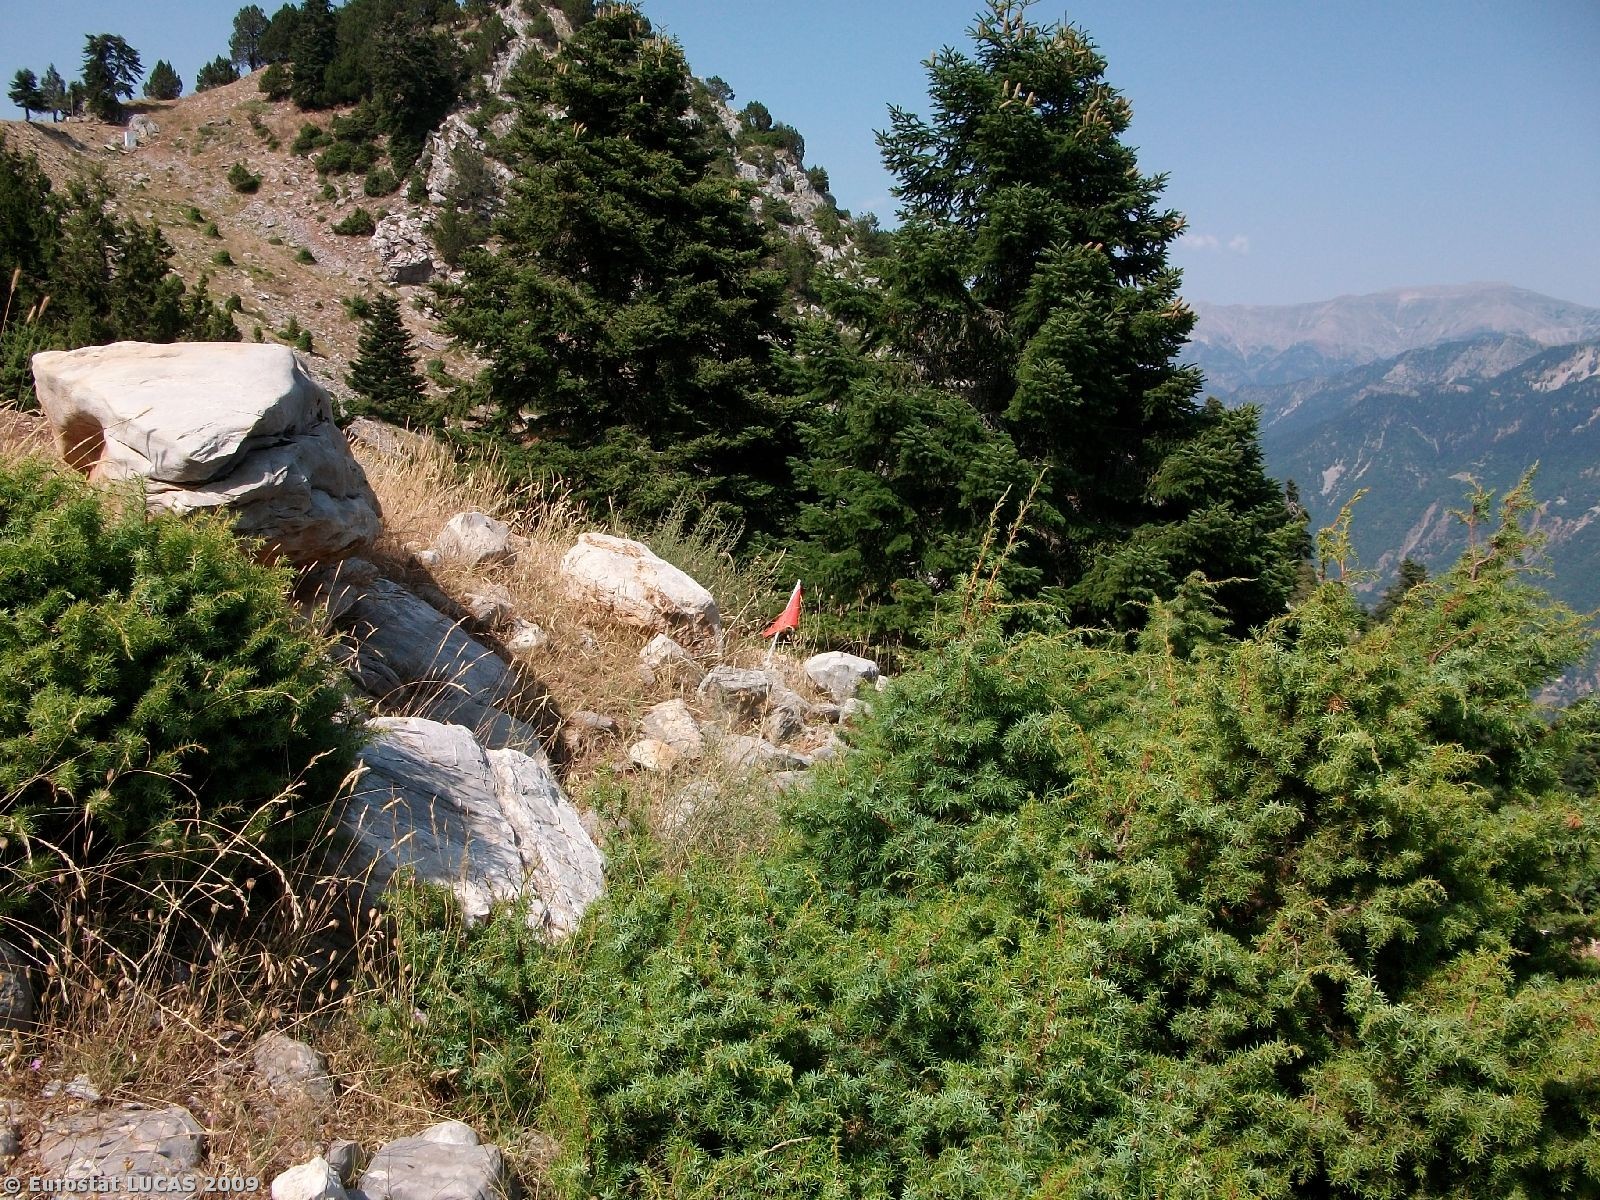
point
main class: Artificial land
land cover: Non built-up linear features
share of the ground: 50 - 75 %
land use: Water supply and treatment
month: August
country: GR
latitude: 39.0690
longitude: 21.5689
